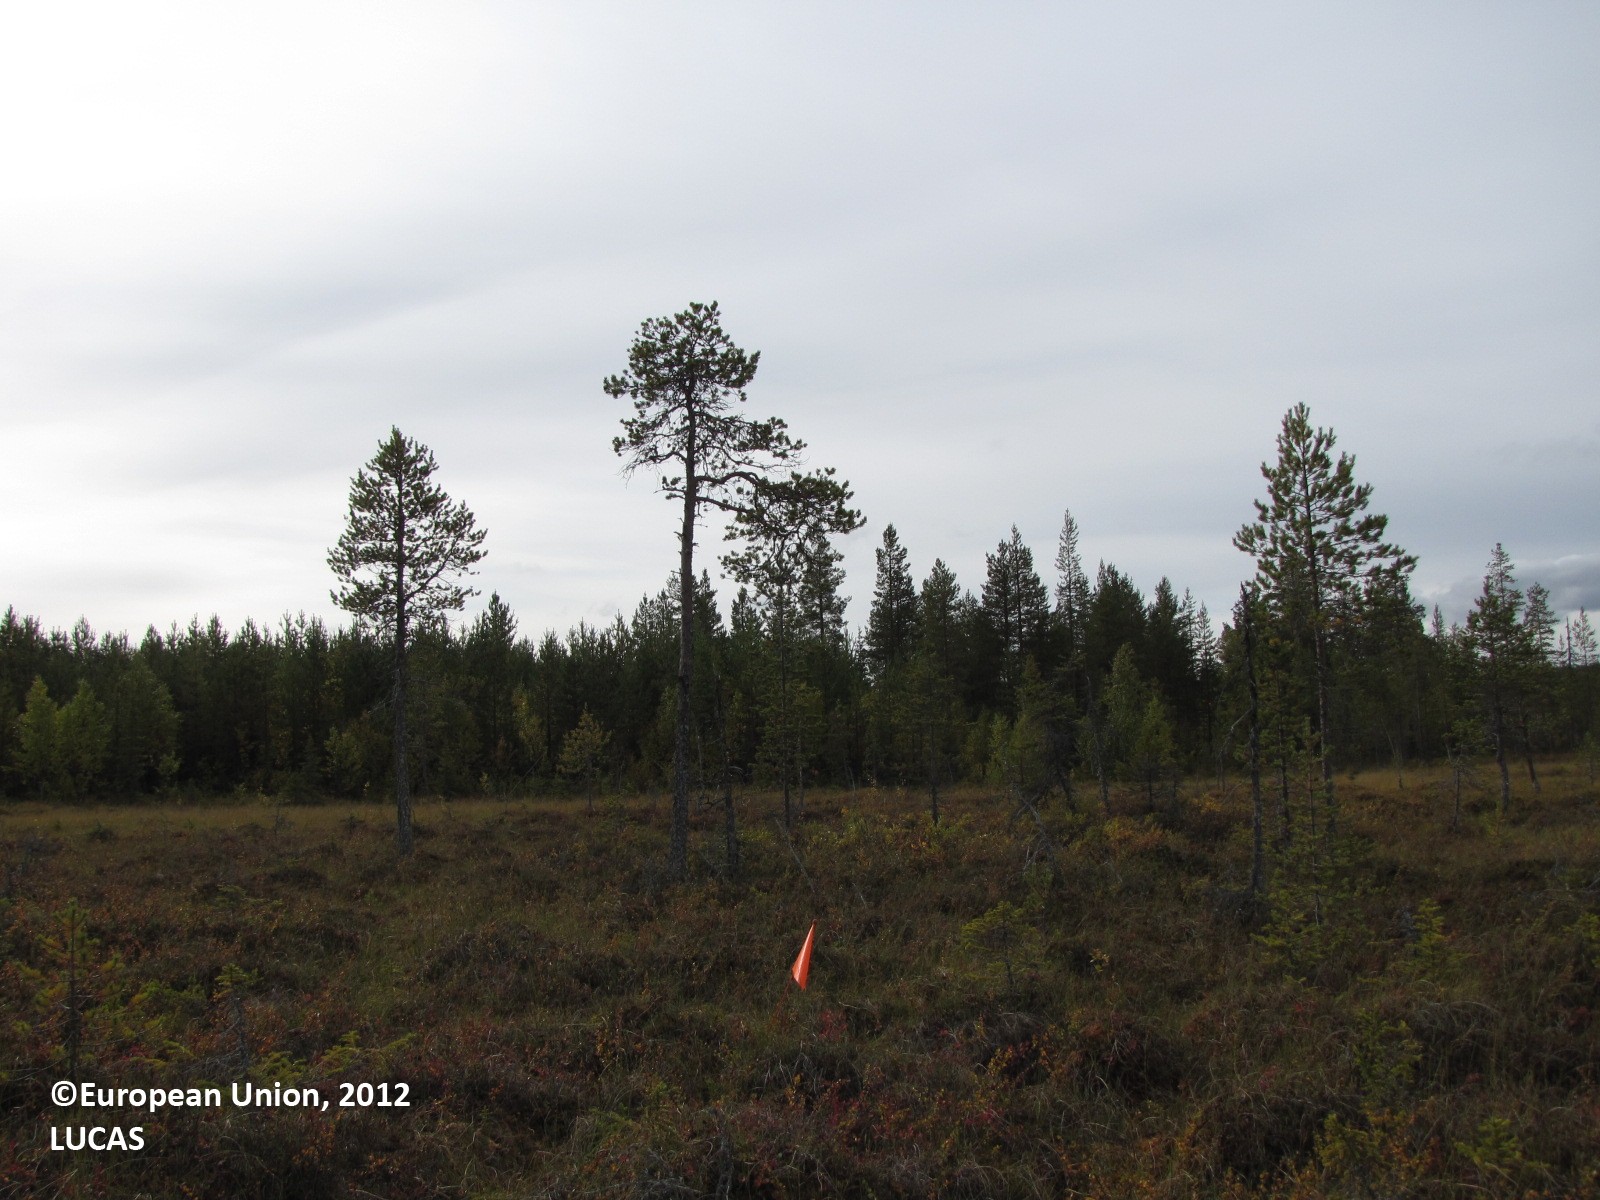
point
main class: Woodland
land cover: Pine dominated coniferous woodland
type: boreal forest
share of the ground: 10 - 25 %
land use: Forestry
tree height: < 5 m
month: September
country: FI
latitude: 67.1478
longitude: 24.8794
